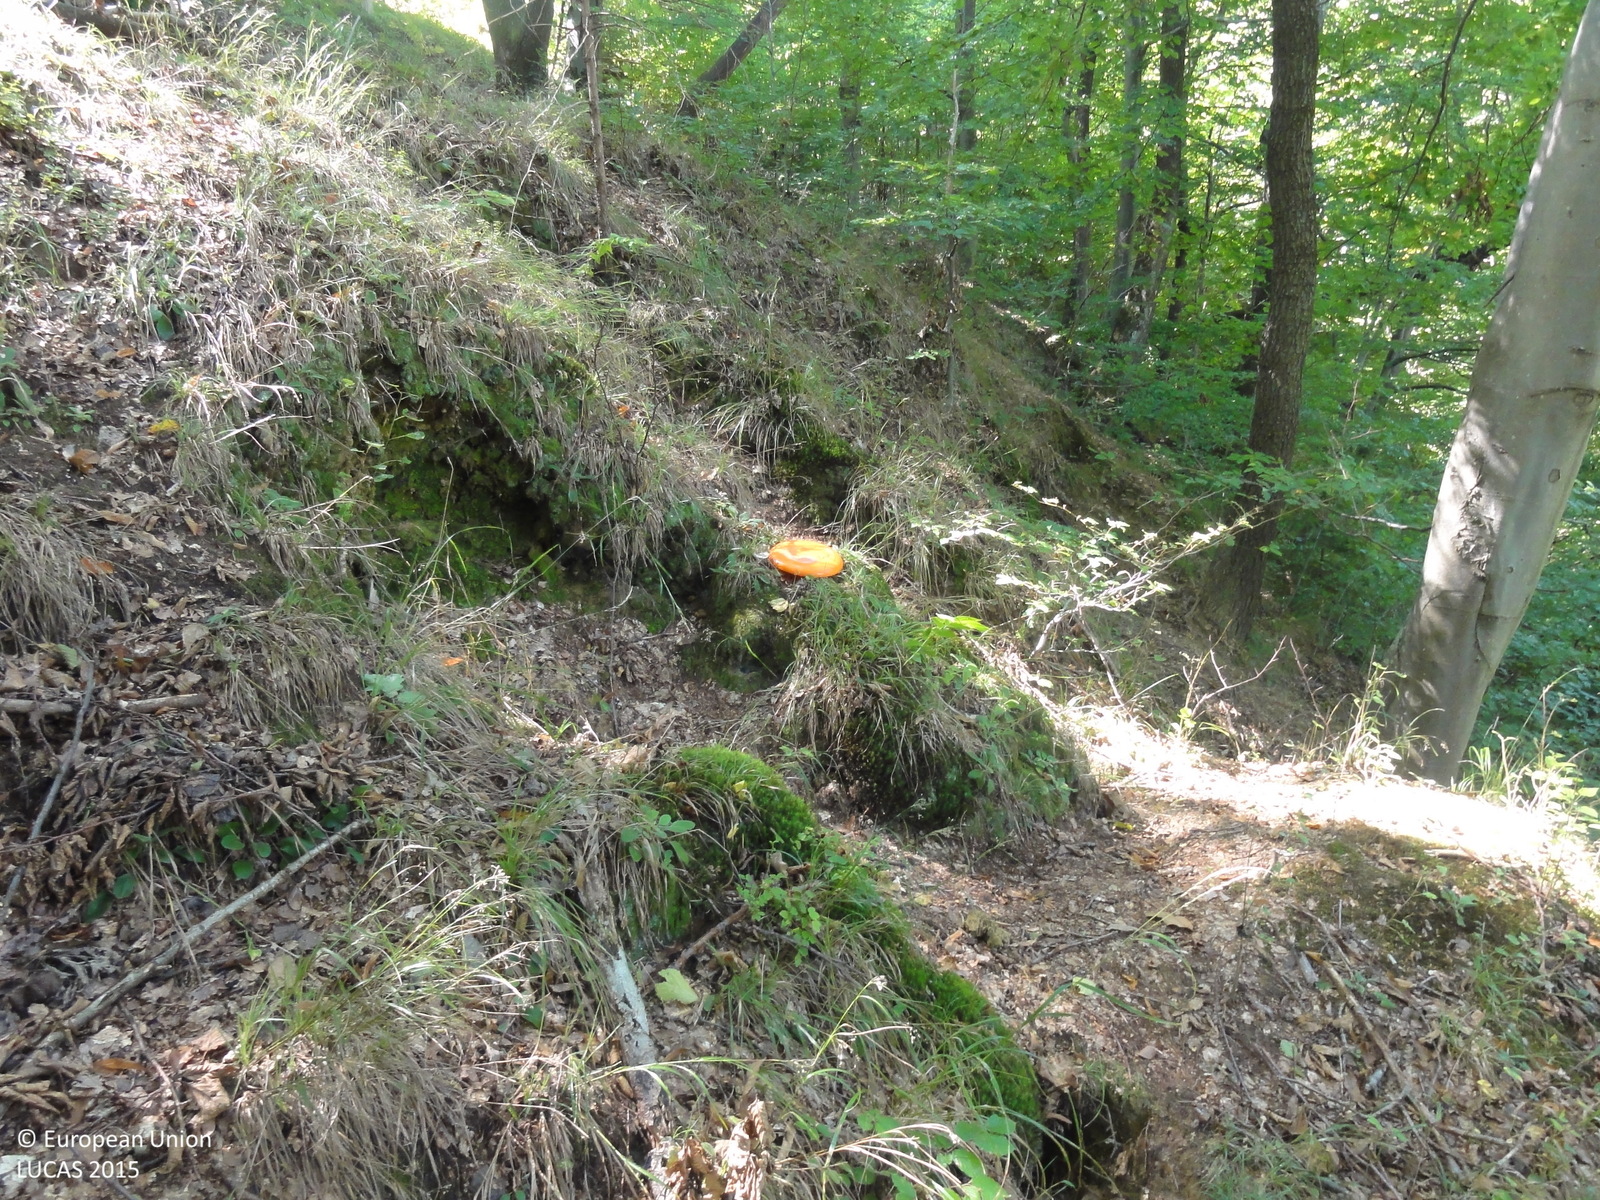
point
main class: Woodland
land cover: Broadleaved woodland
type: beech forest
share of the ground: > 75 %
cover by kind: broadleaved forest trees 95 %, coniferous forest trees 5 %
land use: Forestry
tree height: > 5 m
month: August
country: SI
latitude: 46.0118
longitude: 15.4864
